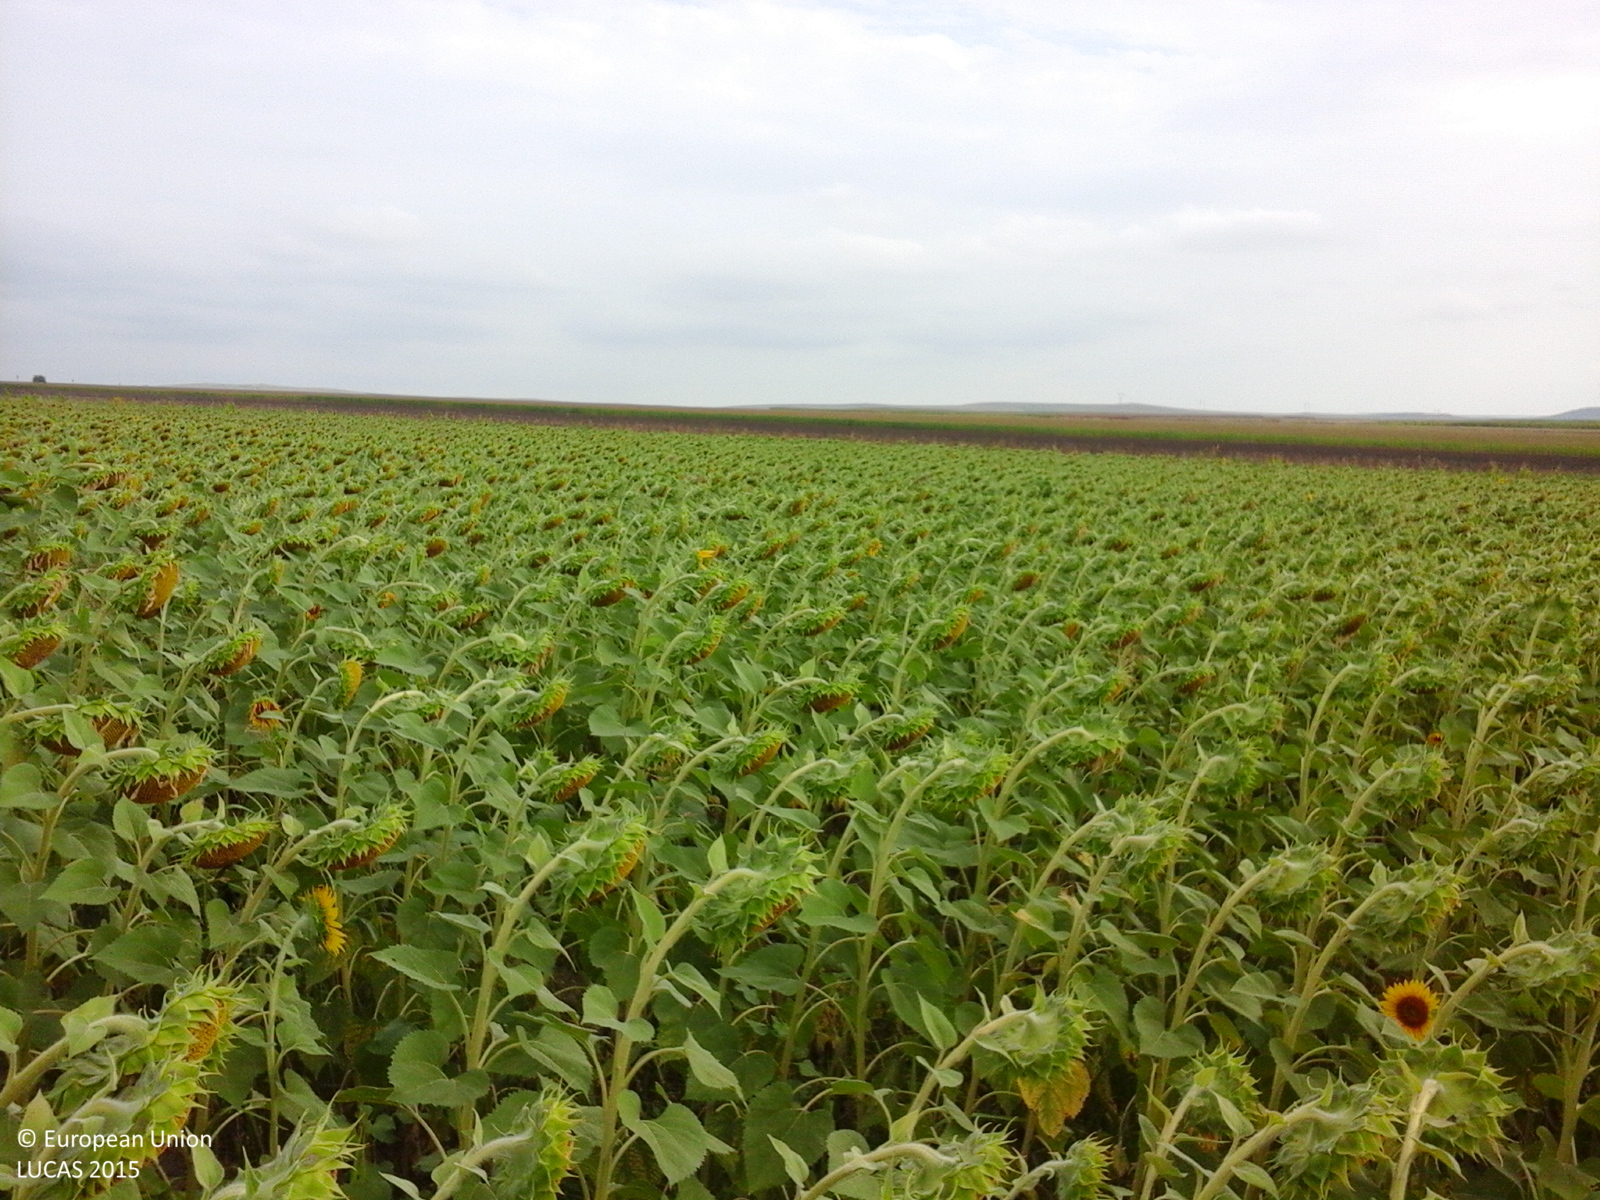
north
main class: Cropland
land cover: Sunflower
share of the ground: > 75 %
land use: Agriculture (excluding fallow land and kitchen gardens)
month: August
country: RO
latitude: 44.7370
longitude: 28.6046
